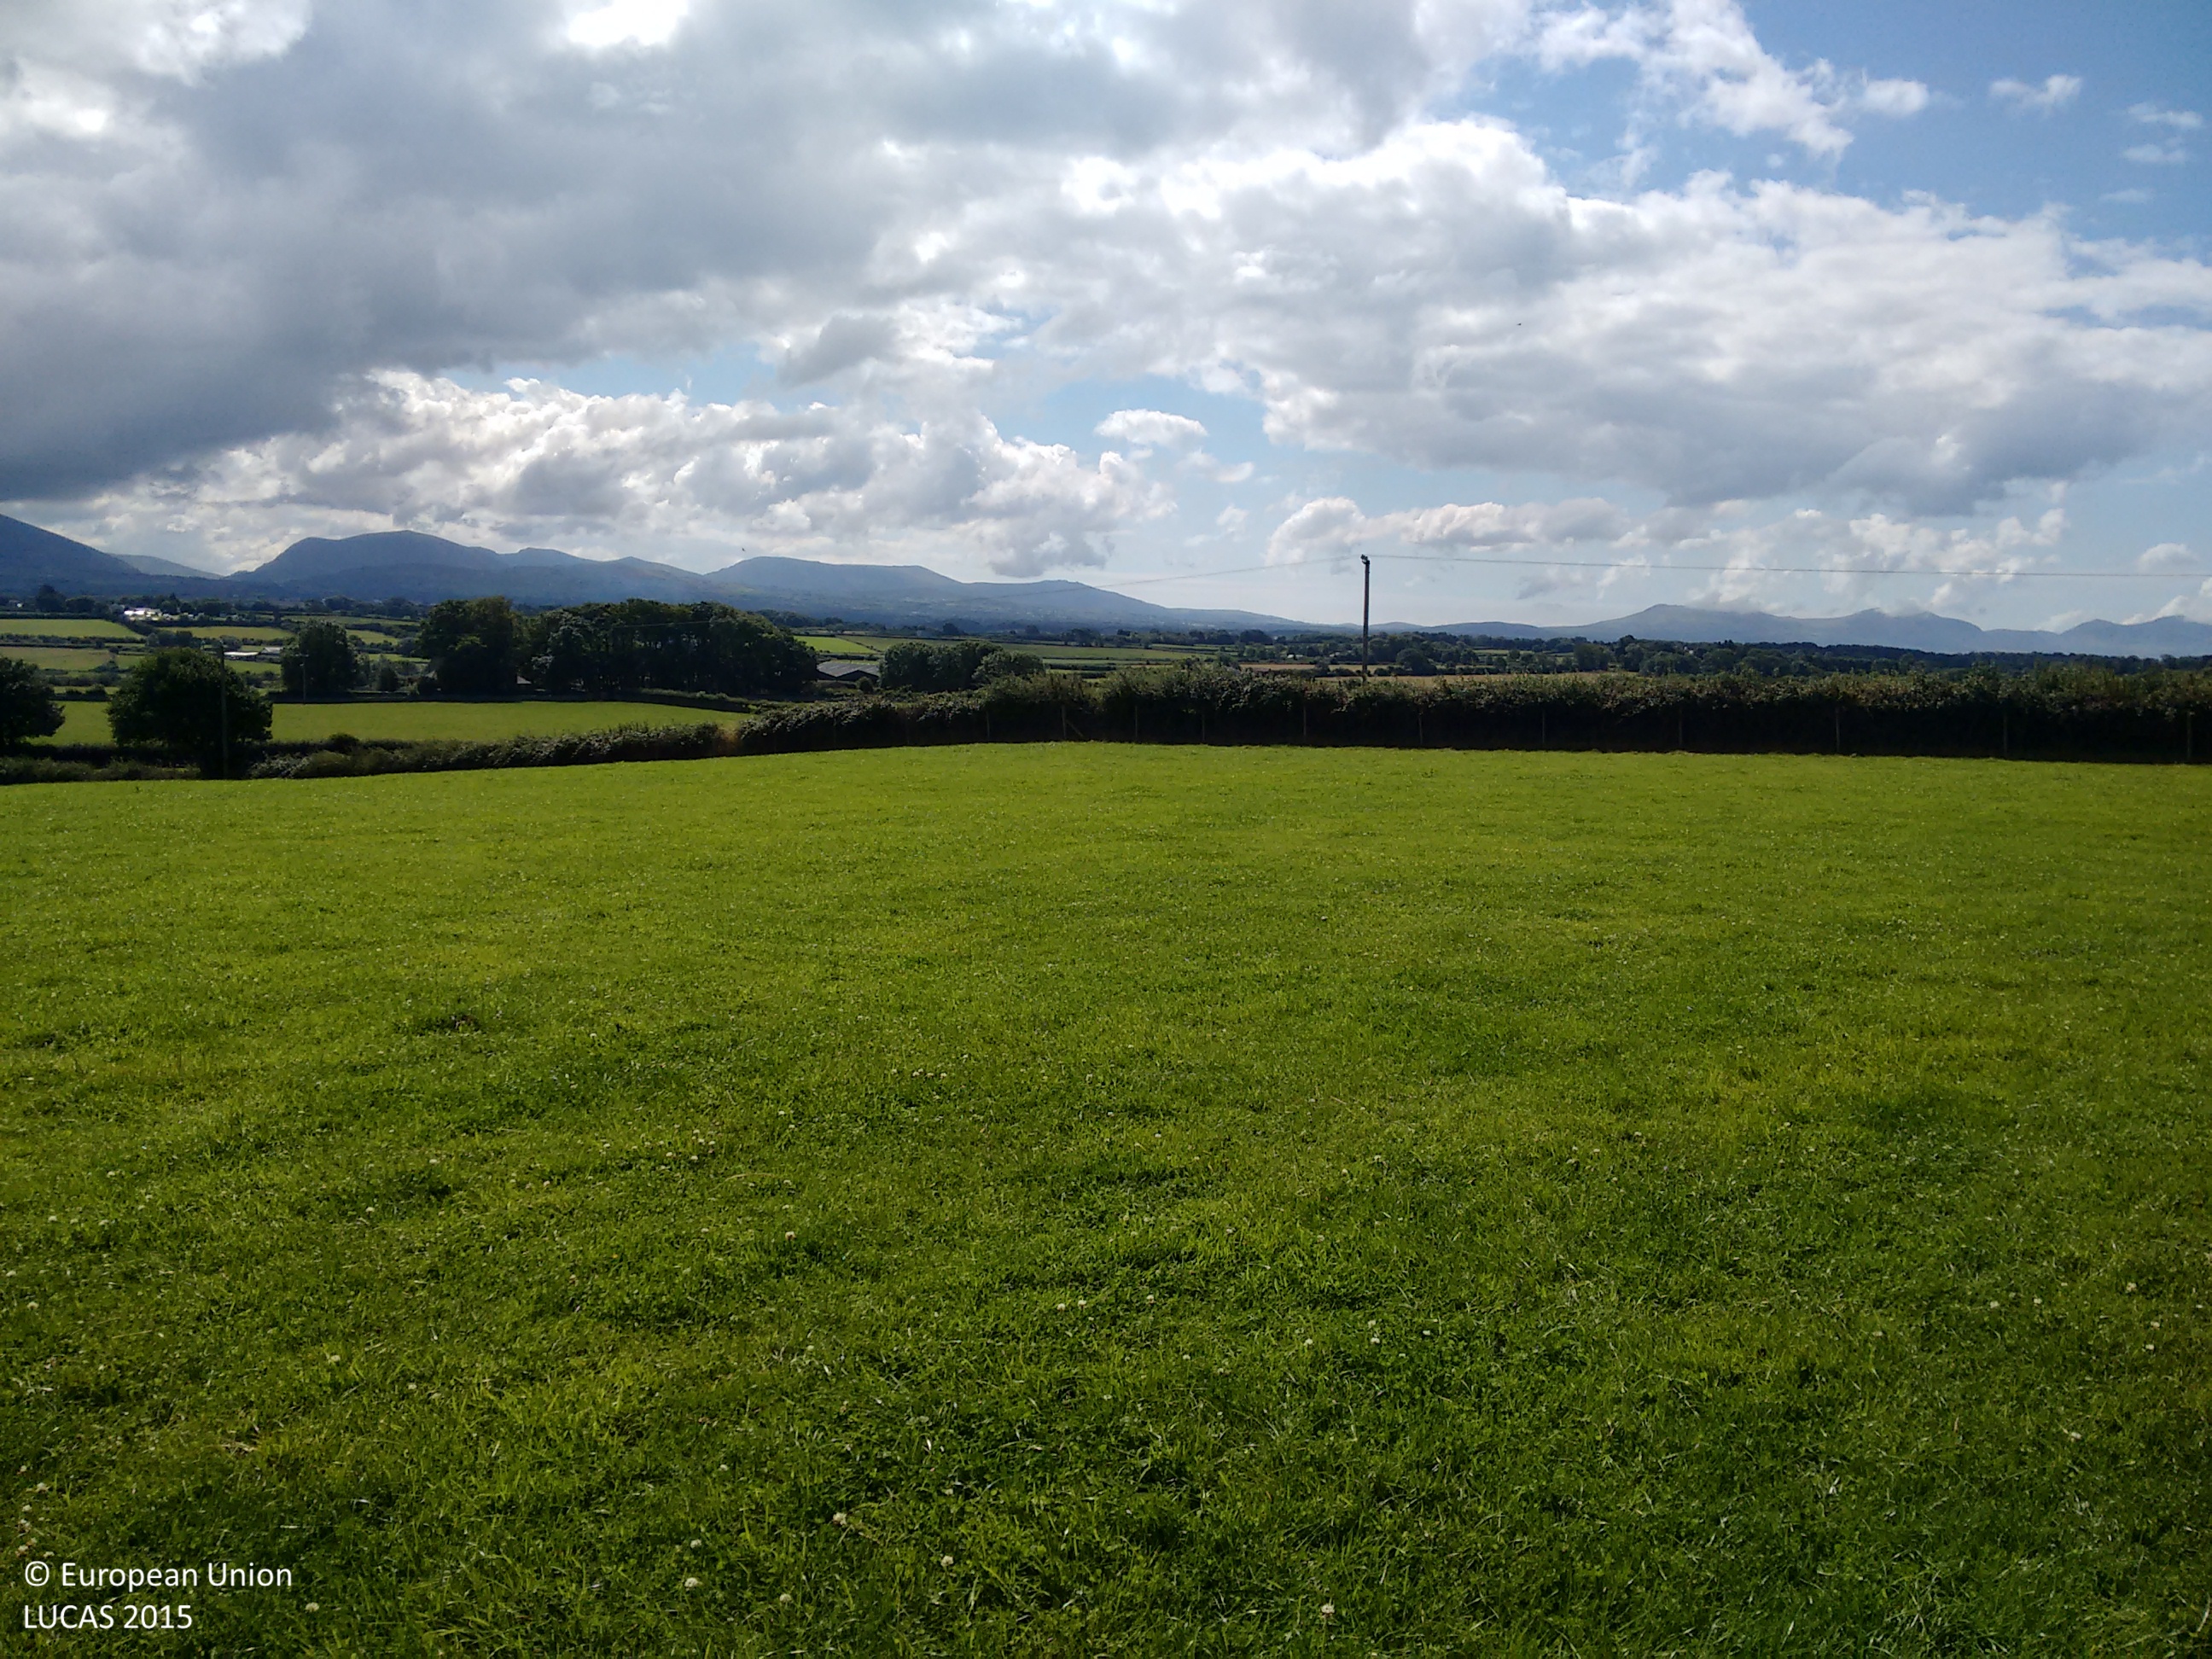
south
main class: Grassland
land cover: Grassland without tree/shrub cover
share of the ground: > 75 %
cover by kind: herbaceous plants 100 %
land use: Agriculture (excluding fallow land and kitchen gardens)
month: August
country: GB
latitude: 53.1865
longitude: -4.3026
